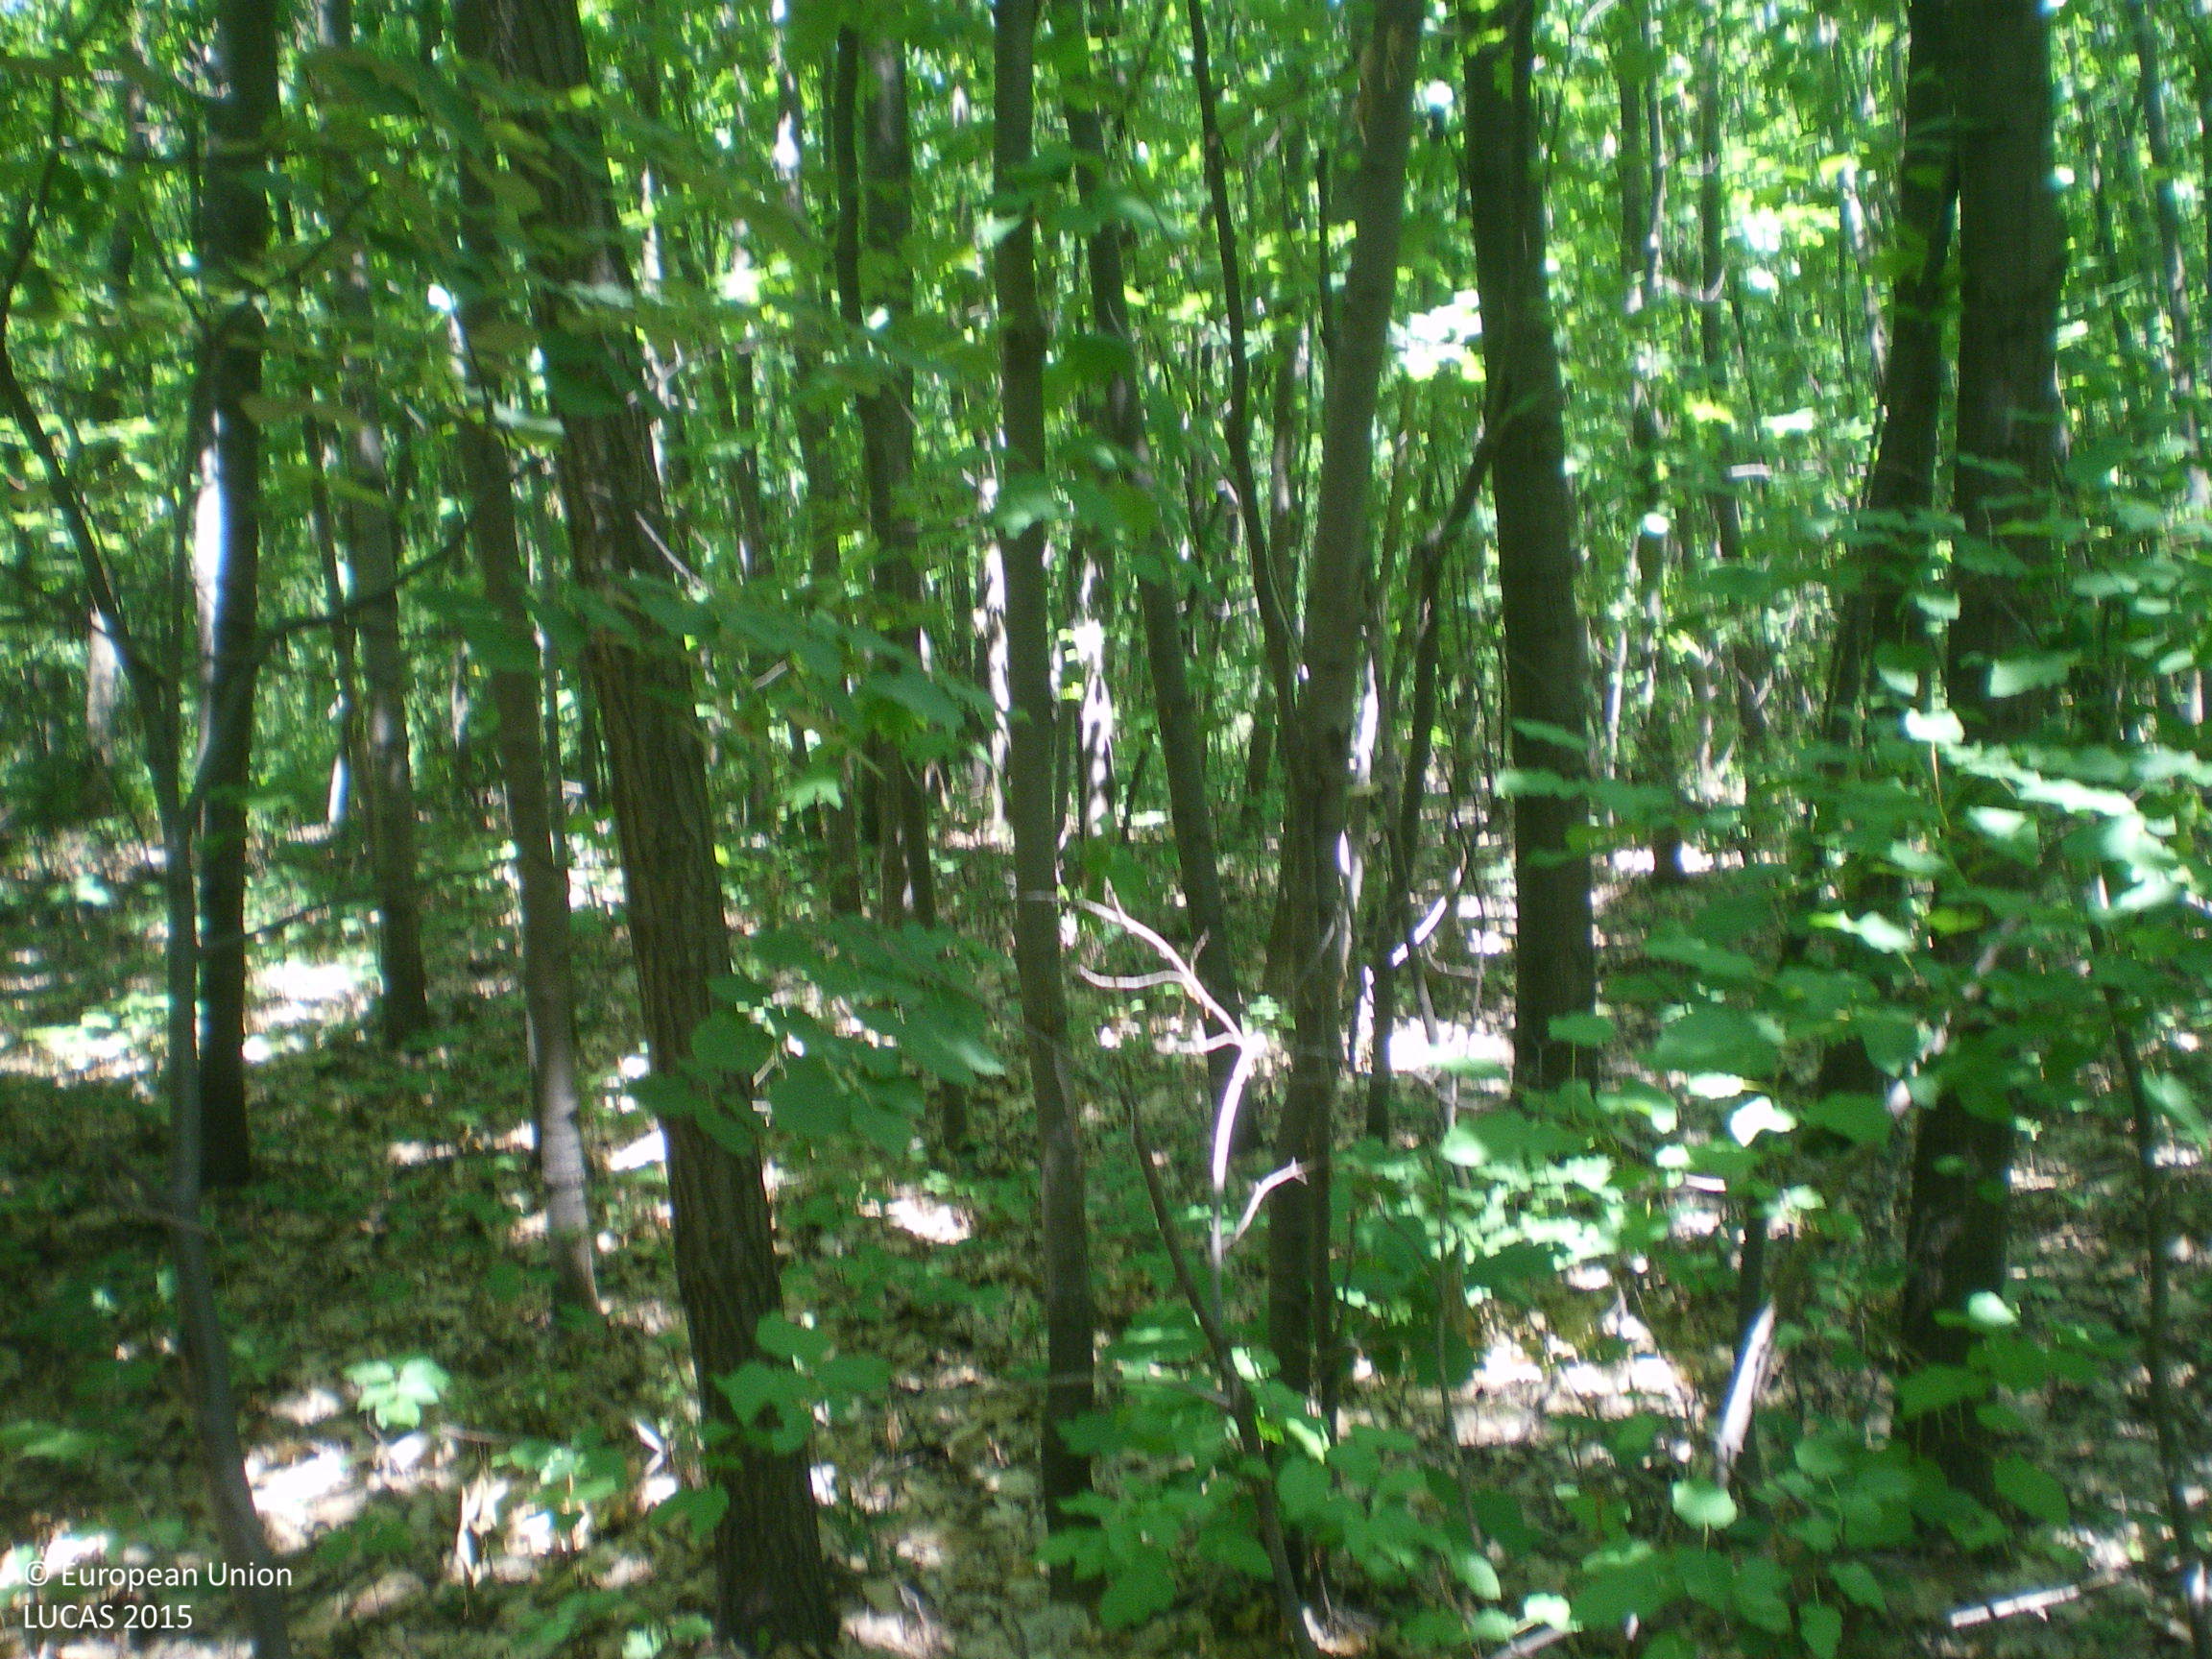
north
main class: Woodland
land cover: Broadleaved woodland
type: mesophytic deciduous forest
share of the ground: > 75 %
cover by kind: broadleaved forest trees 95 %, herbaceous plants 5 %
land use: Forestry
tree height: > 5 m
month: June
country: BG
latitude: 42.2268
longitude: 25.1194
